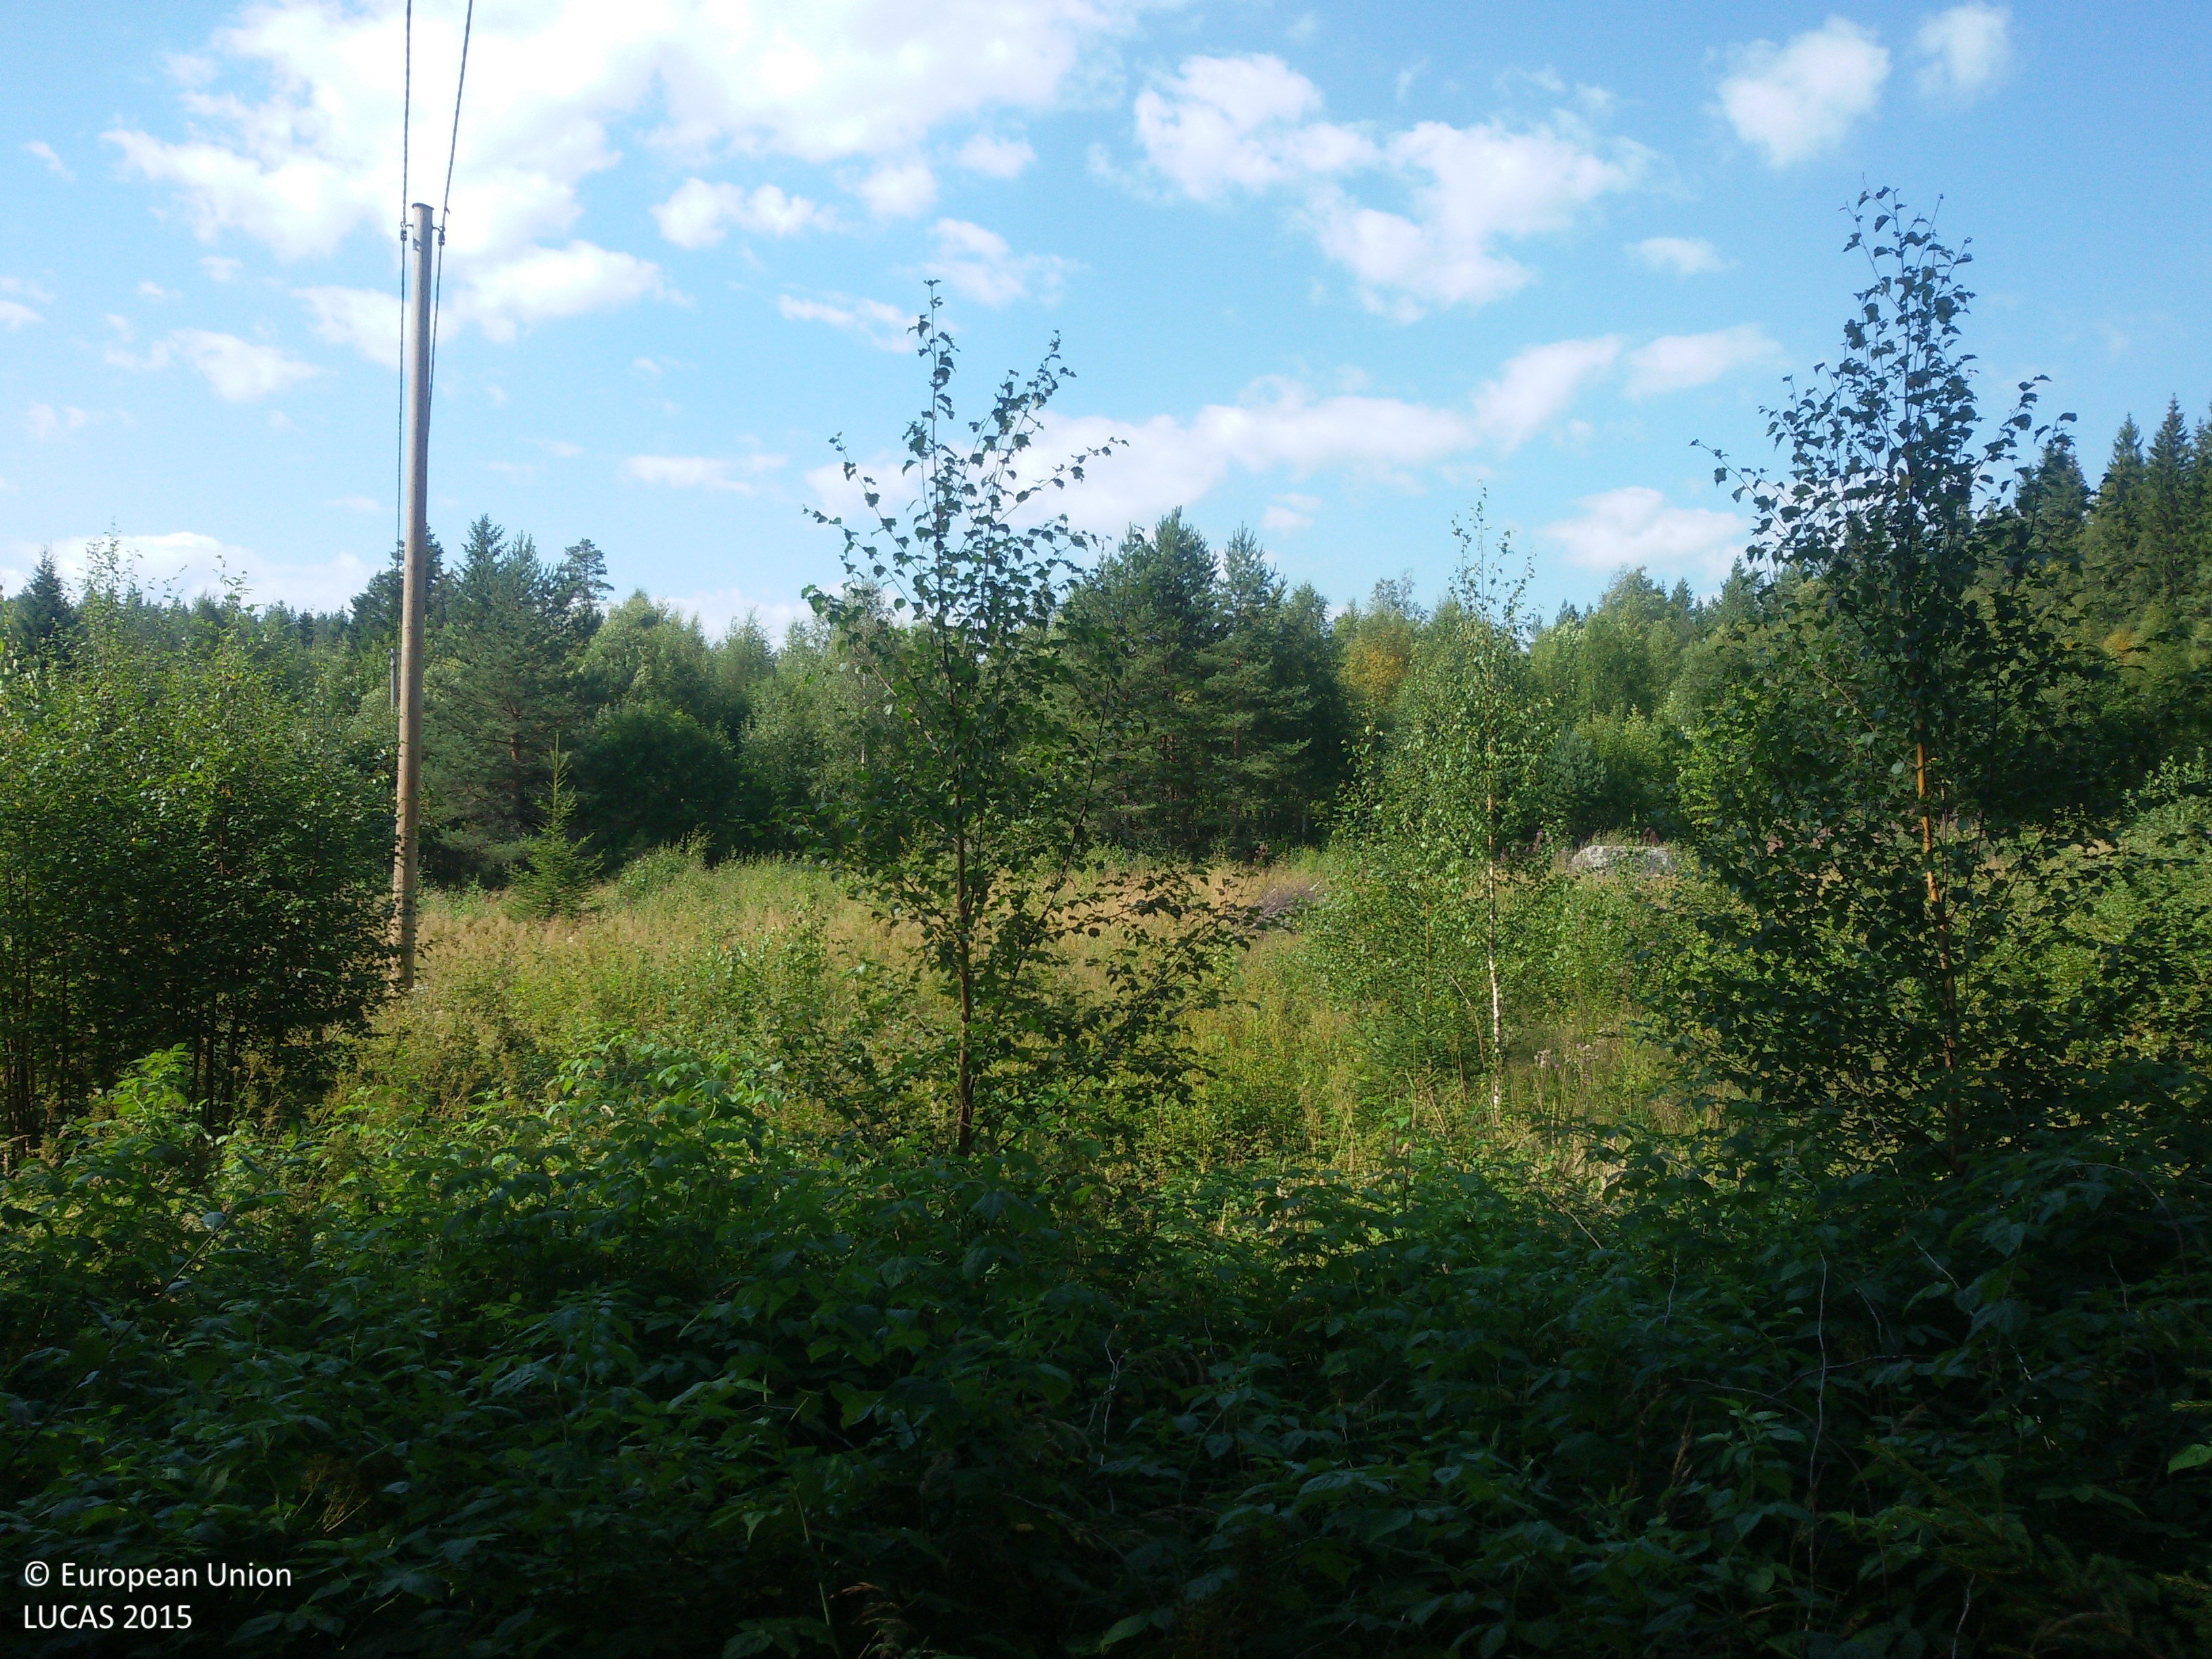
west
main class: Shrubland
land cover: Shrubland with sparse tree cover
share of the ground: > 75 %
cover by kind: shrubs 90 %, broadleaved forest trees 5 %, herbaceous plants 5 %
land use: Semi-natural and natural areas not in use
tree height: < 5 m
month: August
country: SE
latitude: 60.7355
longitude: 16.0938
